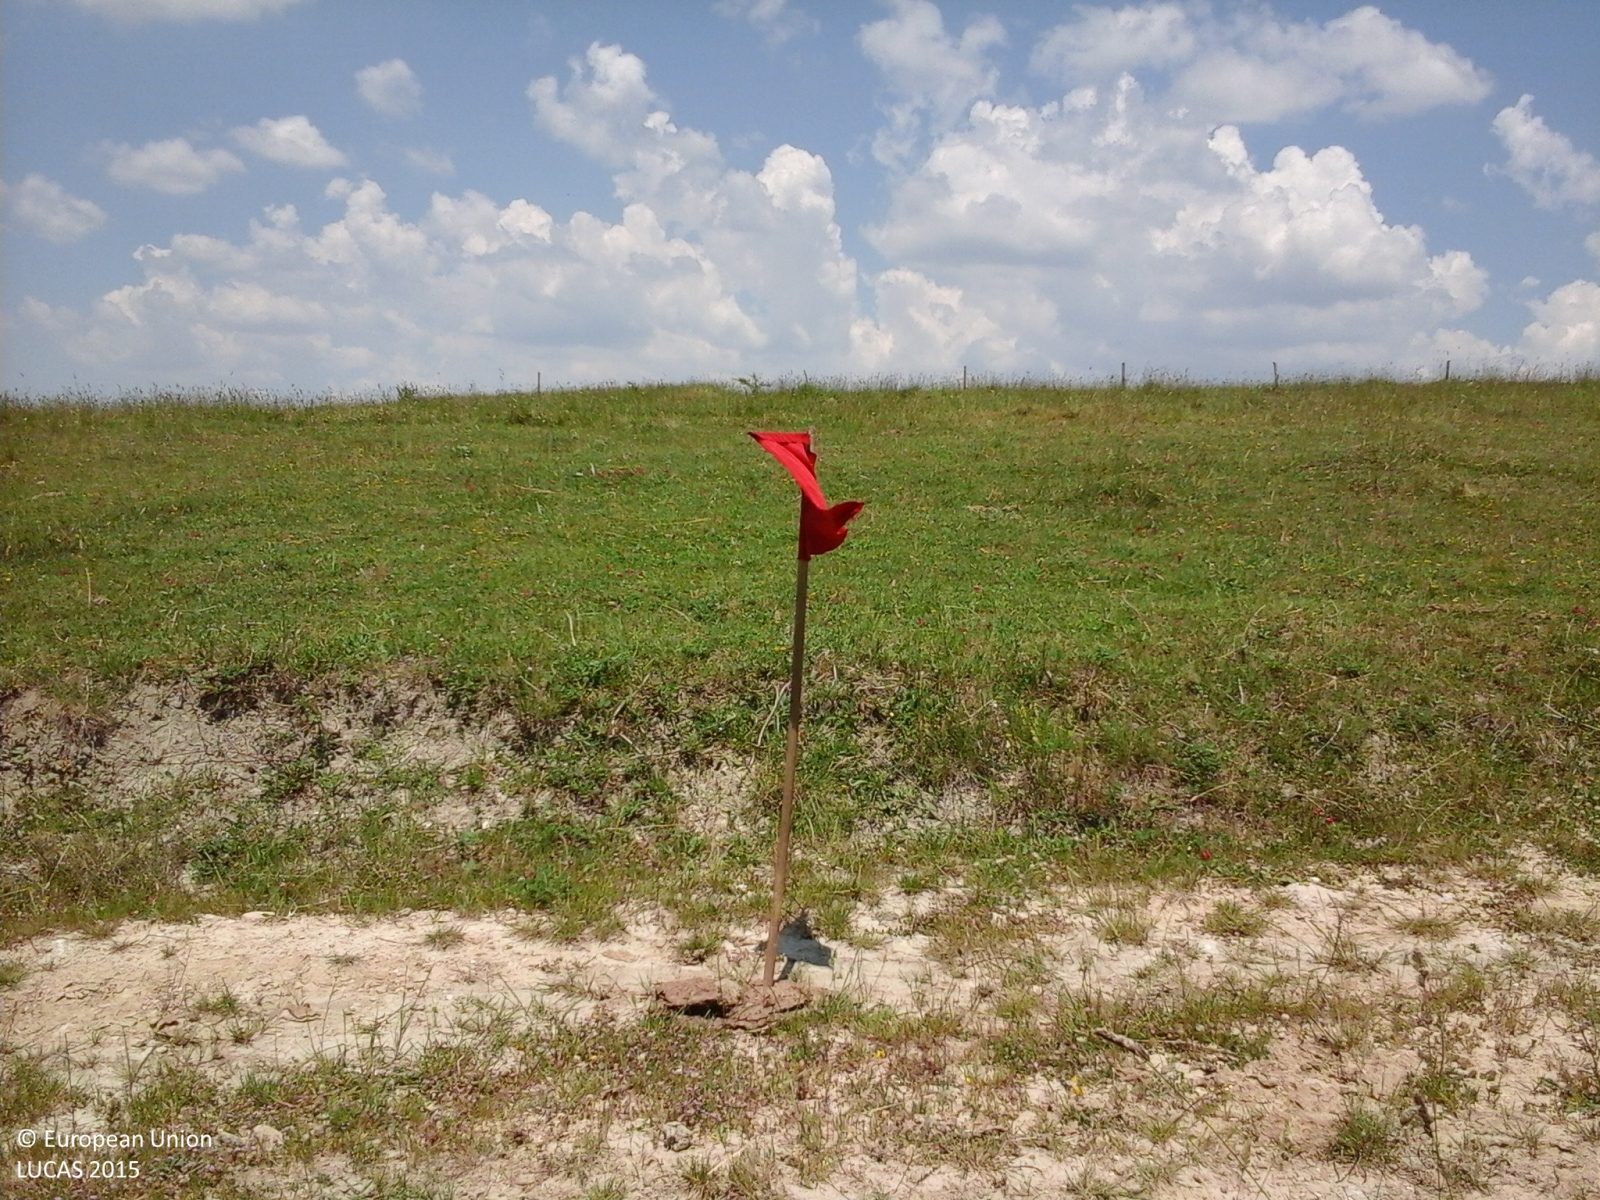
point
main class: Grassland
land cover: Grassland without tree/shrub cover
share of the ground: > 75 %
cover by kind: herbaceous plants 100 %
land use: Agriculture (excluding fallow land and kitchen gardens)
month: June
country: IT
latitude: 41.1463
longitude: 15.1641
